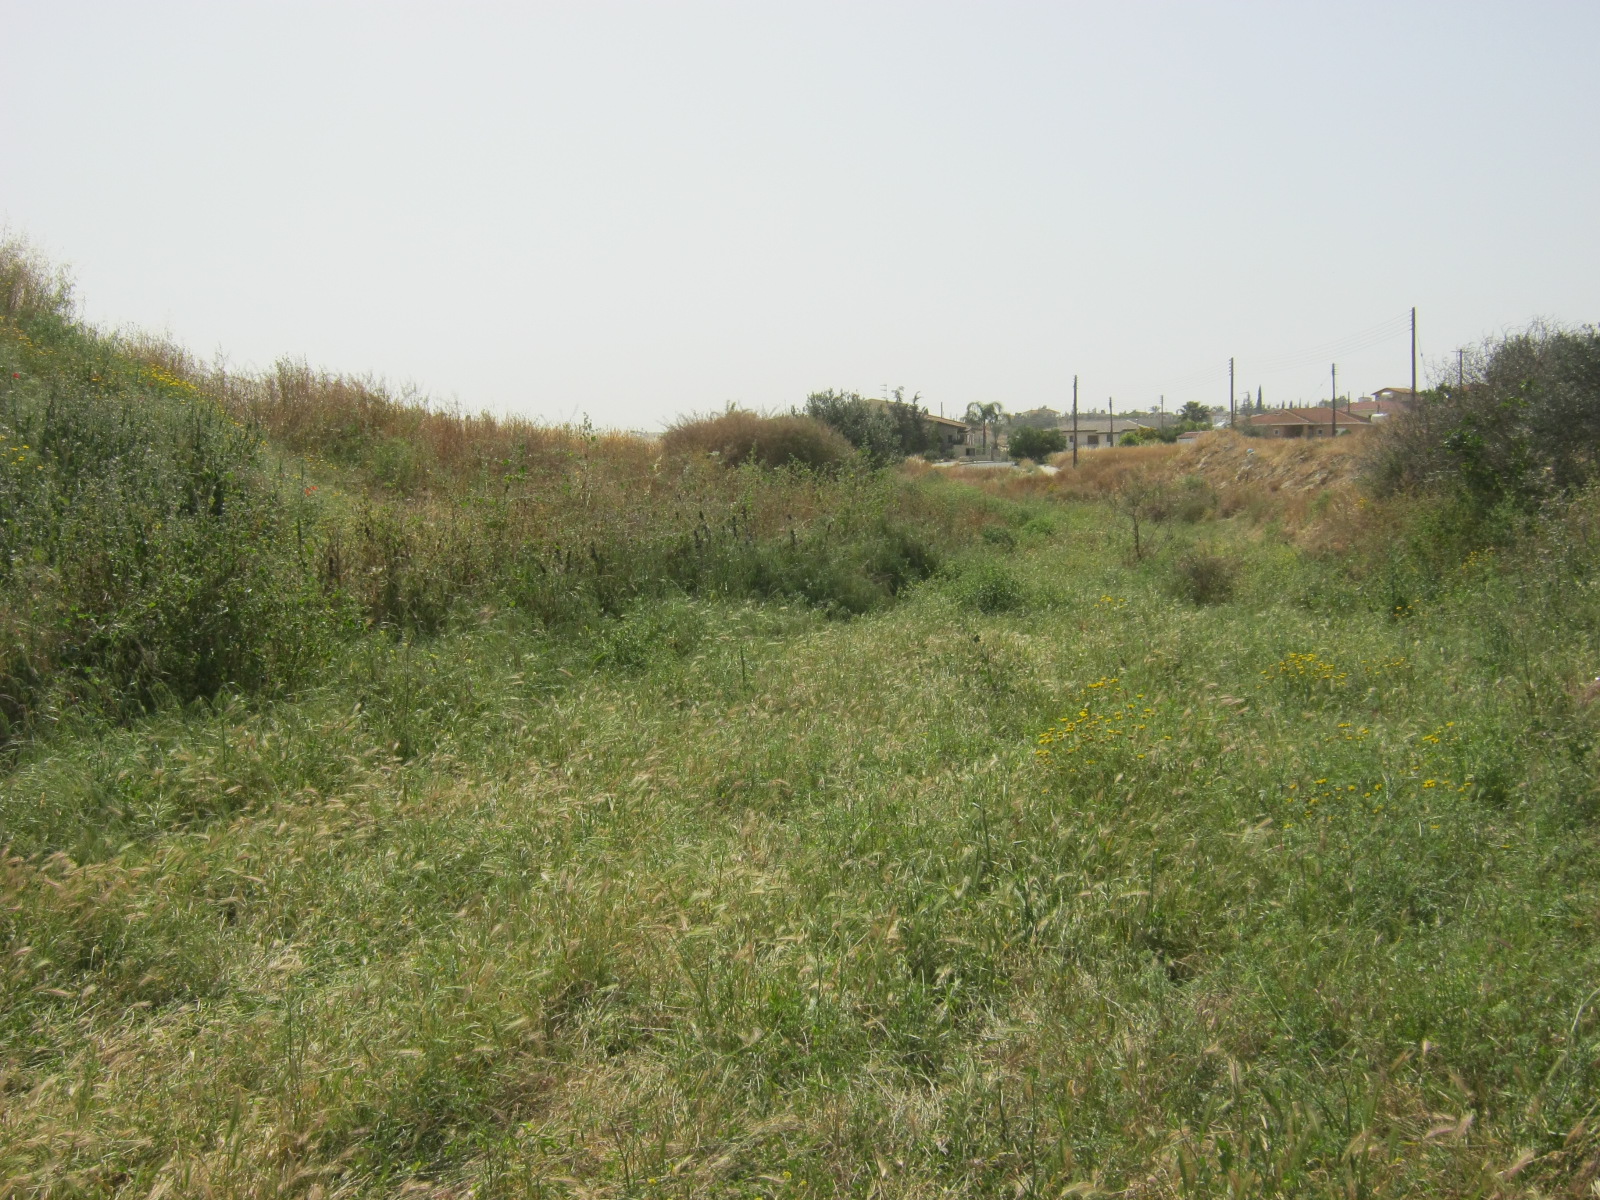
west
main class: Grassland
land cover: Spontaneously vegetated surfaces
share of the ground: > 75 %
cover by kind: herbaceous plants 100 %
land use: Semi-natural and natural areas not in use
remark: Temporary dry
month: April
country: CY
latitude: 35.0991
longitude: 33.4174
